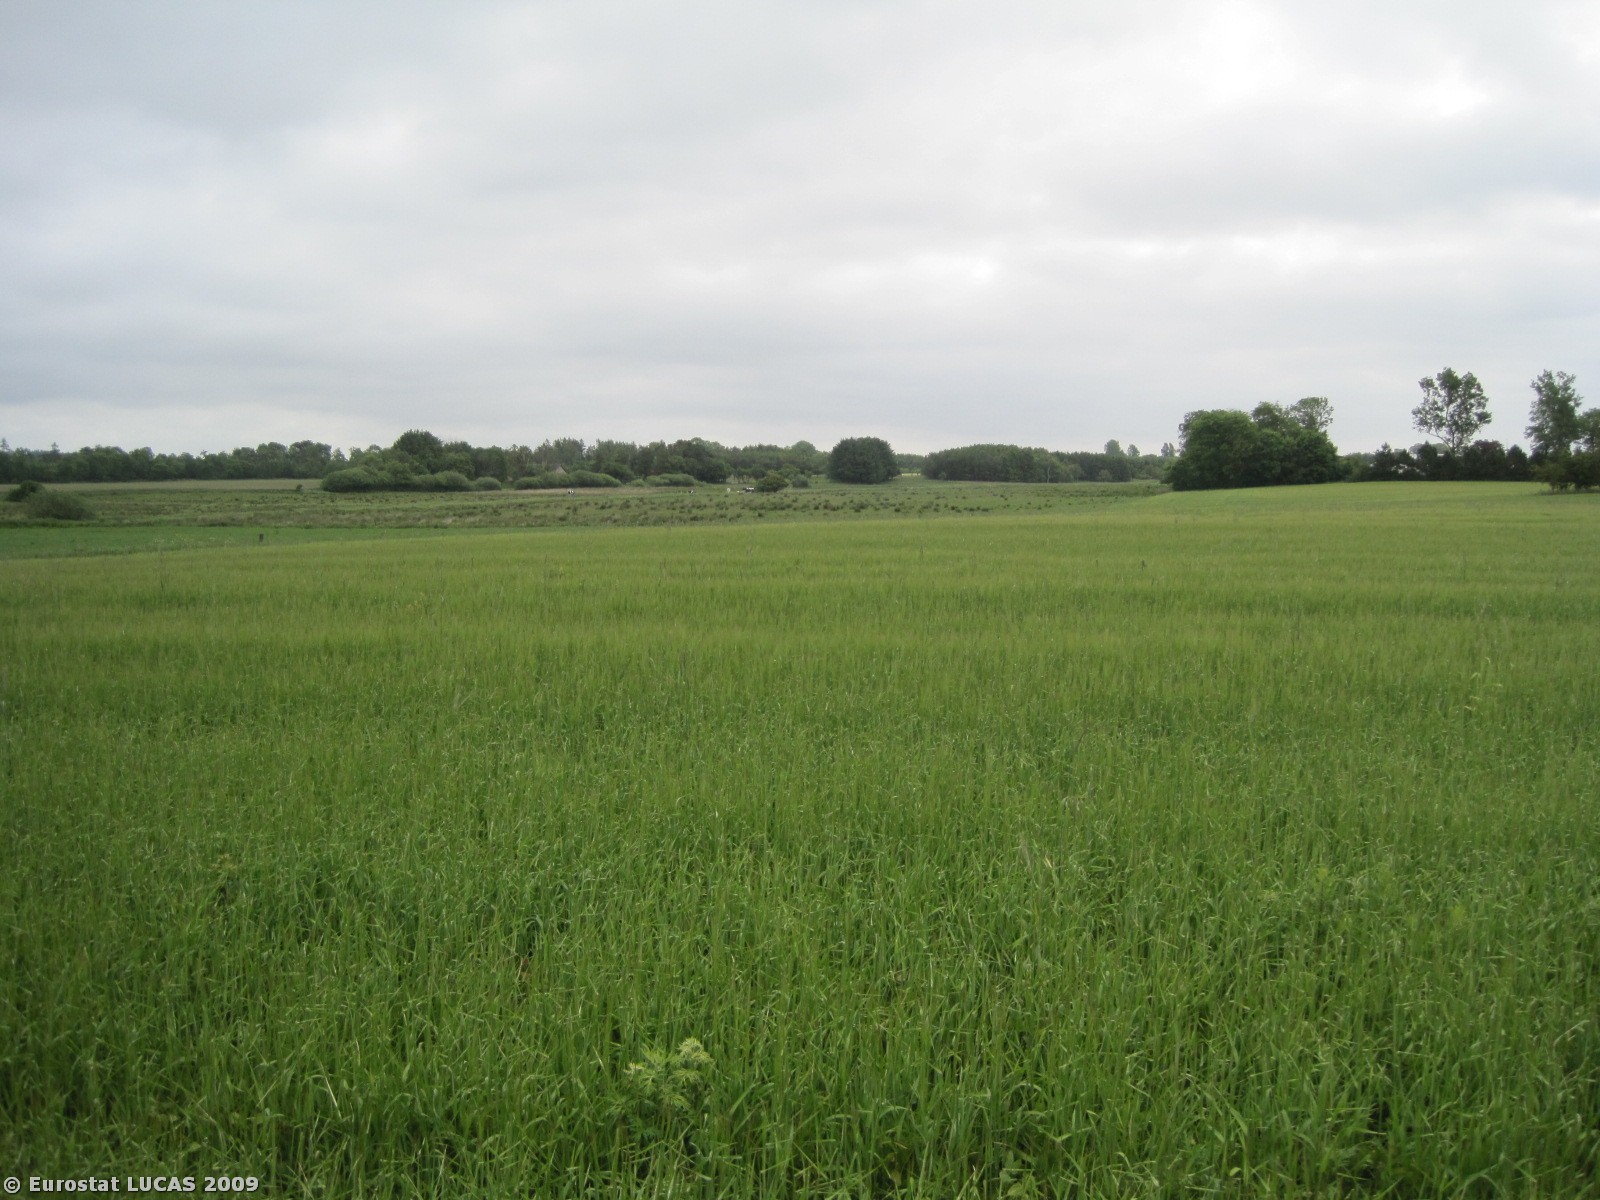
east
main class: Cropland
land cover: Barley
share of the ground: > 75 %
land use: Agriculture (excluding fallow land and kitchen gardens)
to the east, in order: Barley; Grass margins; Ditches and canals; Grass margins; Fences; Grass margins; Barley; Grass margins; Fences; Grass margins; Ditches and canals; Grass margins; Fences; Grassland without tree/shrub cover
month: June
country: DK
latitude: 57.1944
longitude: 10.0826
